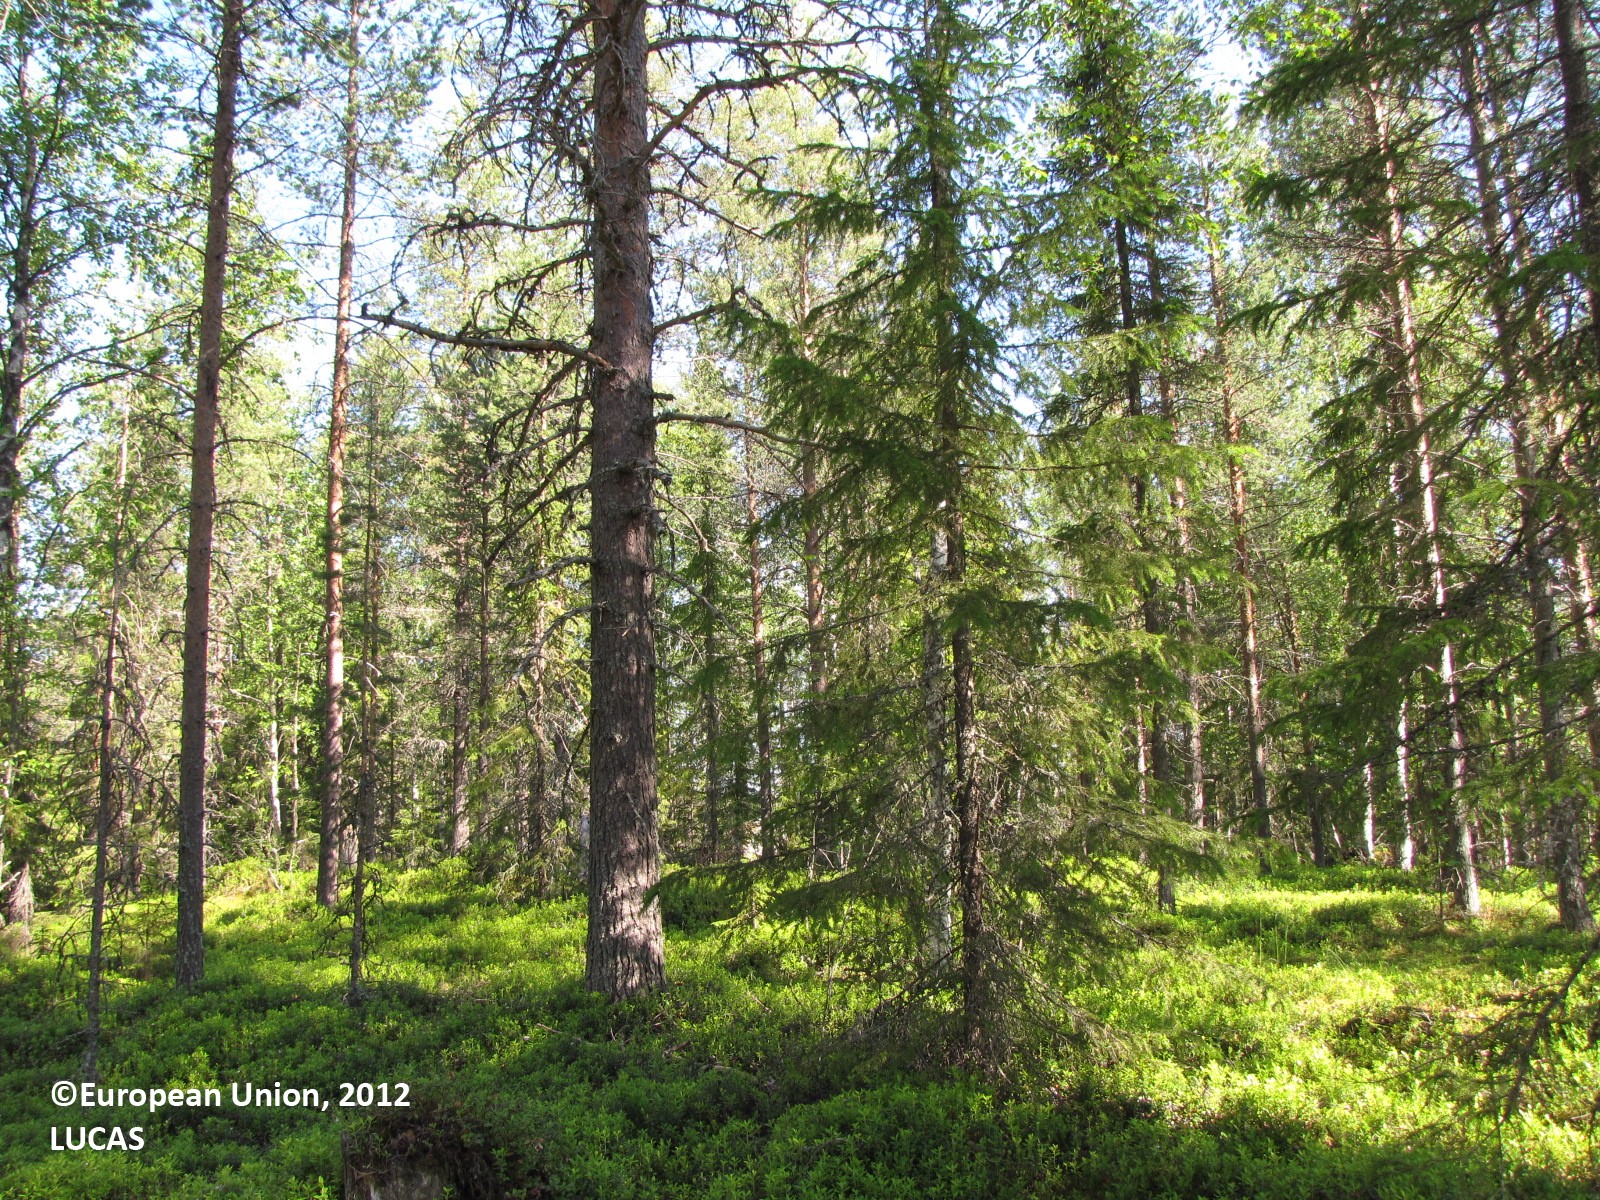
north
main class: Woodland
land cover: Pine dominated coniferous woodland
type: boreal forest
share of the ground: 50 - 75 %
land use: Forestry
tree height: > 5 m
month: July
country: FI
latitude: 66.3704
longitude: 25.2870
